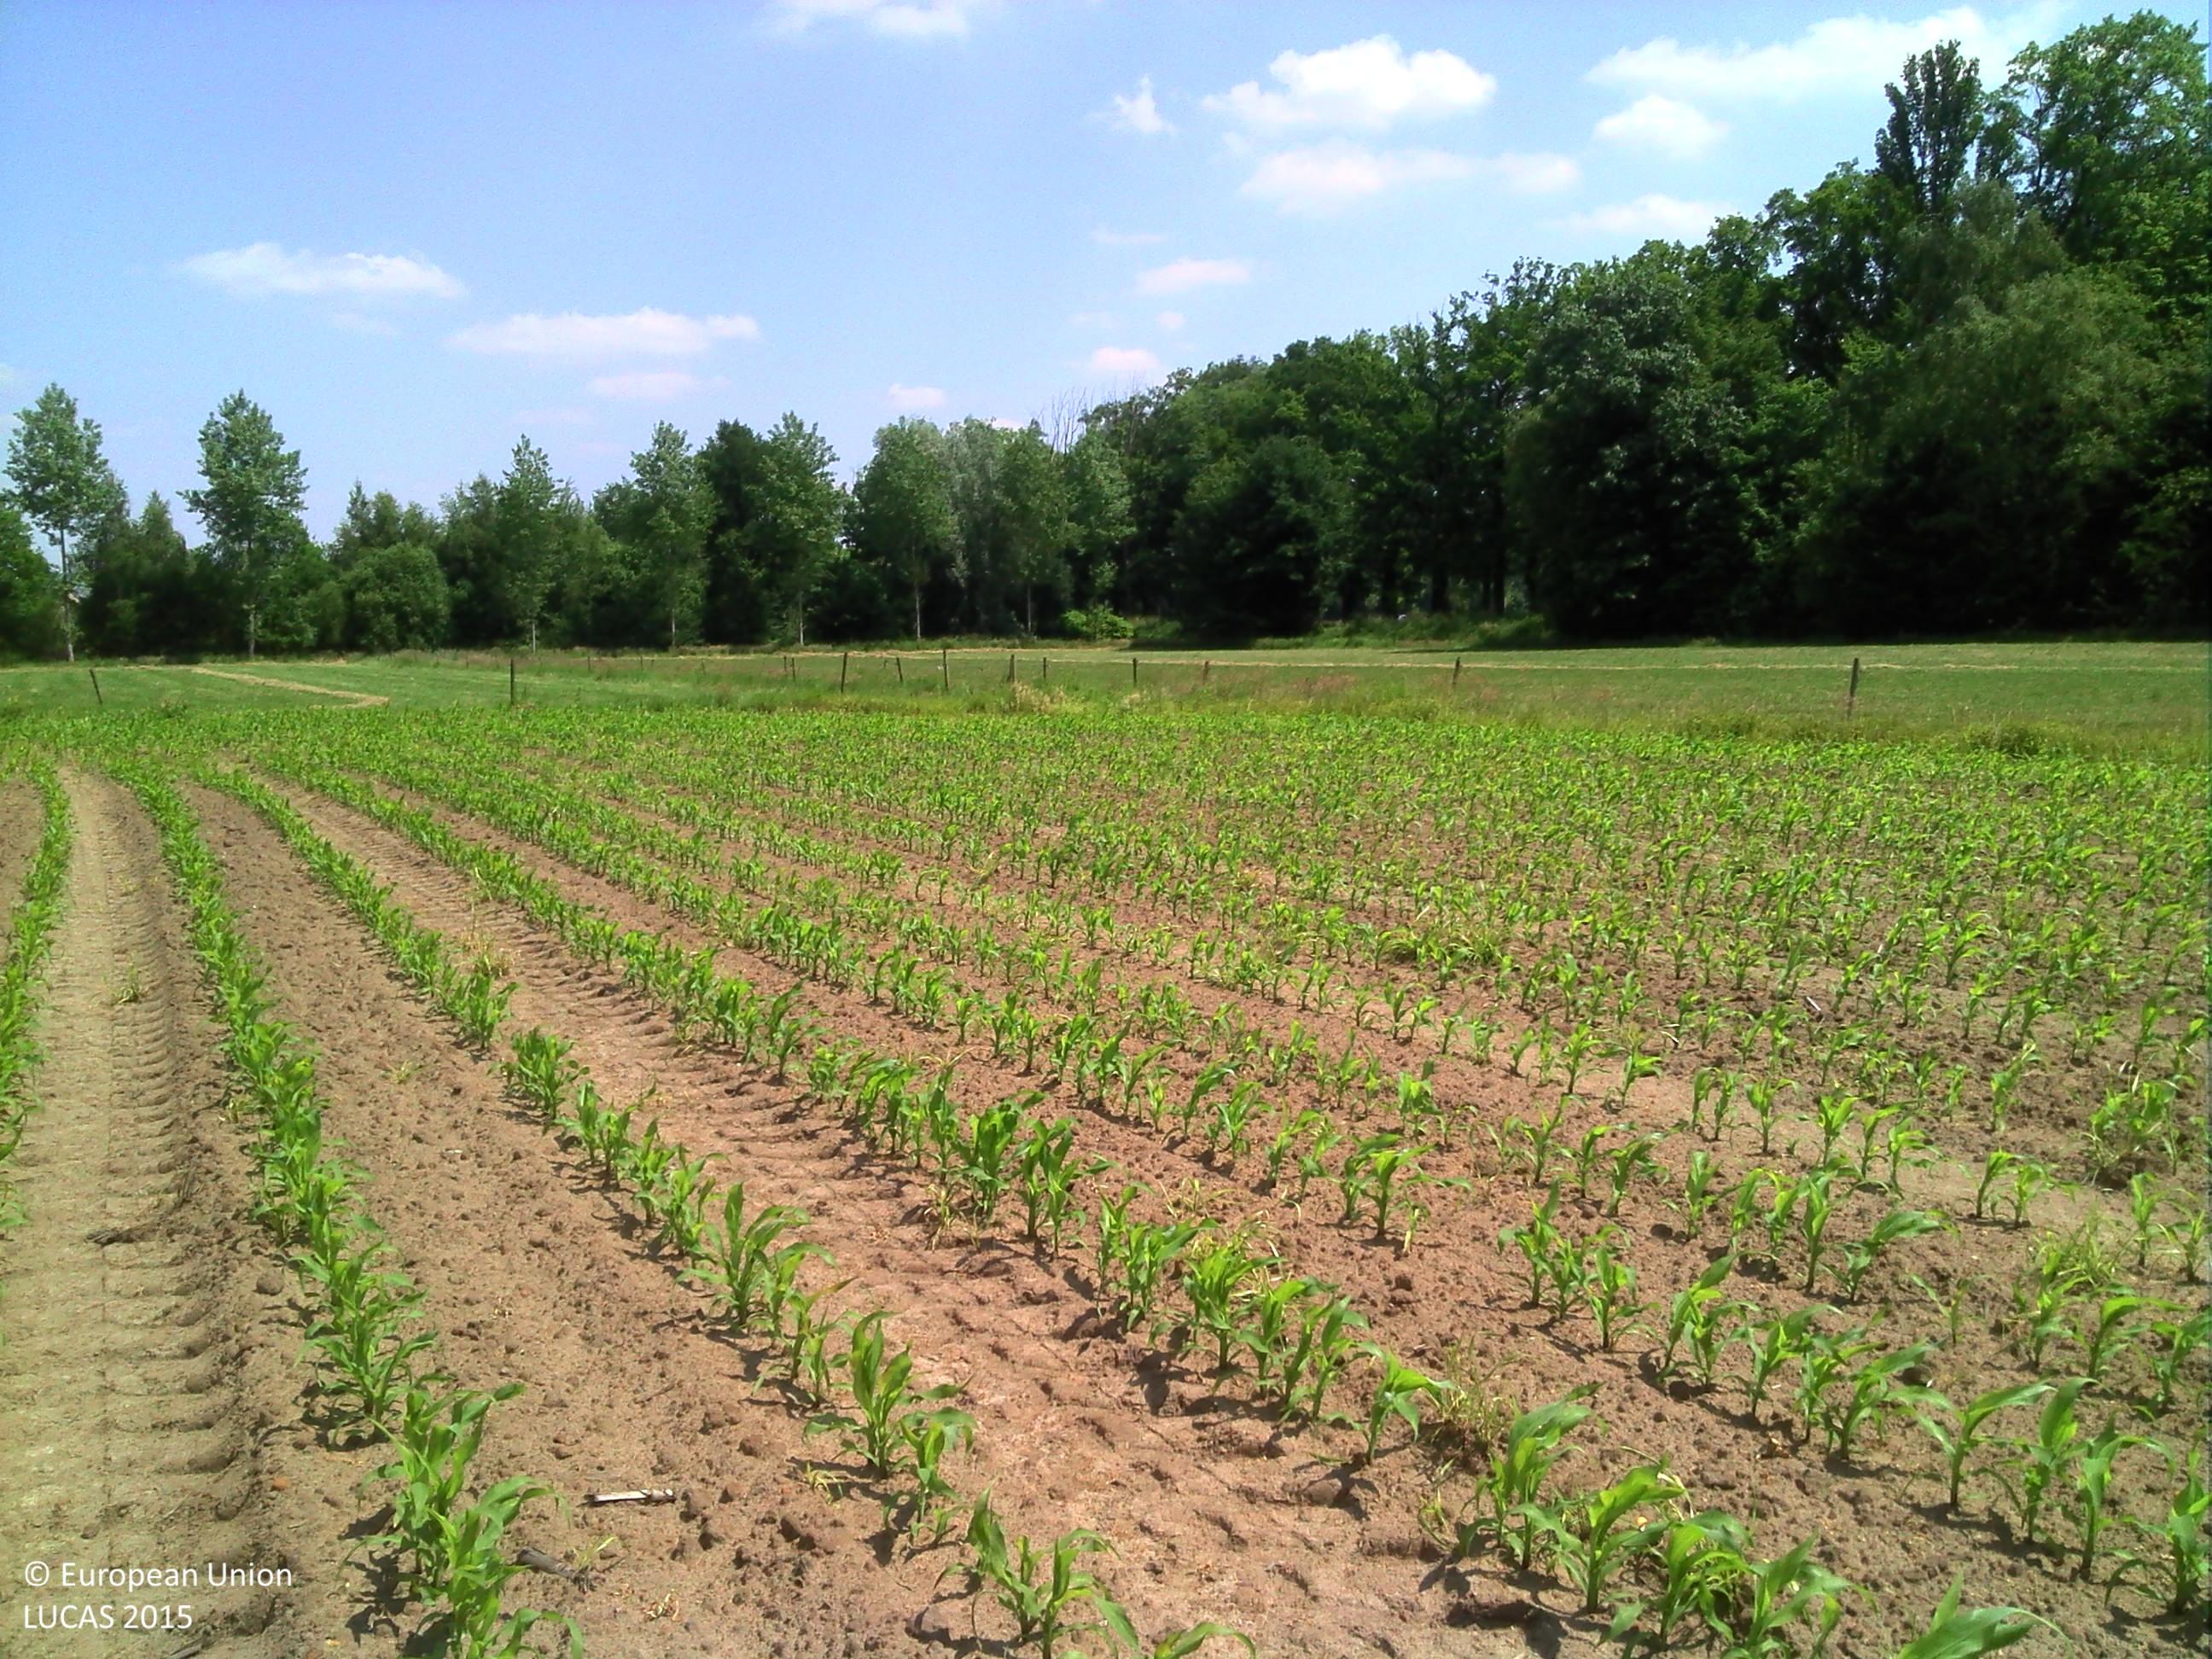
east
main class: Cropland
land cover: Maize
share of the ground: 25 - 50 %
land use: Agriculture (excluding fallow land and kitchen gardens)
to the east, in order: Maize; Grass margins; Ditches and canals; Grass margins; Fences; Grassland without tree/shrub cover; Fences; Grass margins; Inland fresh running water; Grassland without tree/shrub cover; Inland fresh running water; Grass margins; Lines of trees; Grass margins; Tracks; Grass margins; Lines of trees; Grass margins; Grassland without tree/shrub cover
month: June
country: BE
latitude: 50.9837
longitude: 5.1971
